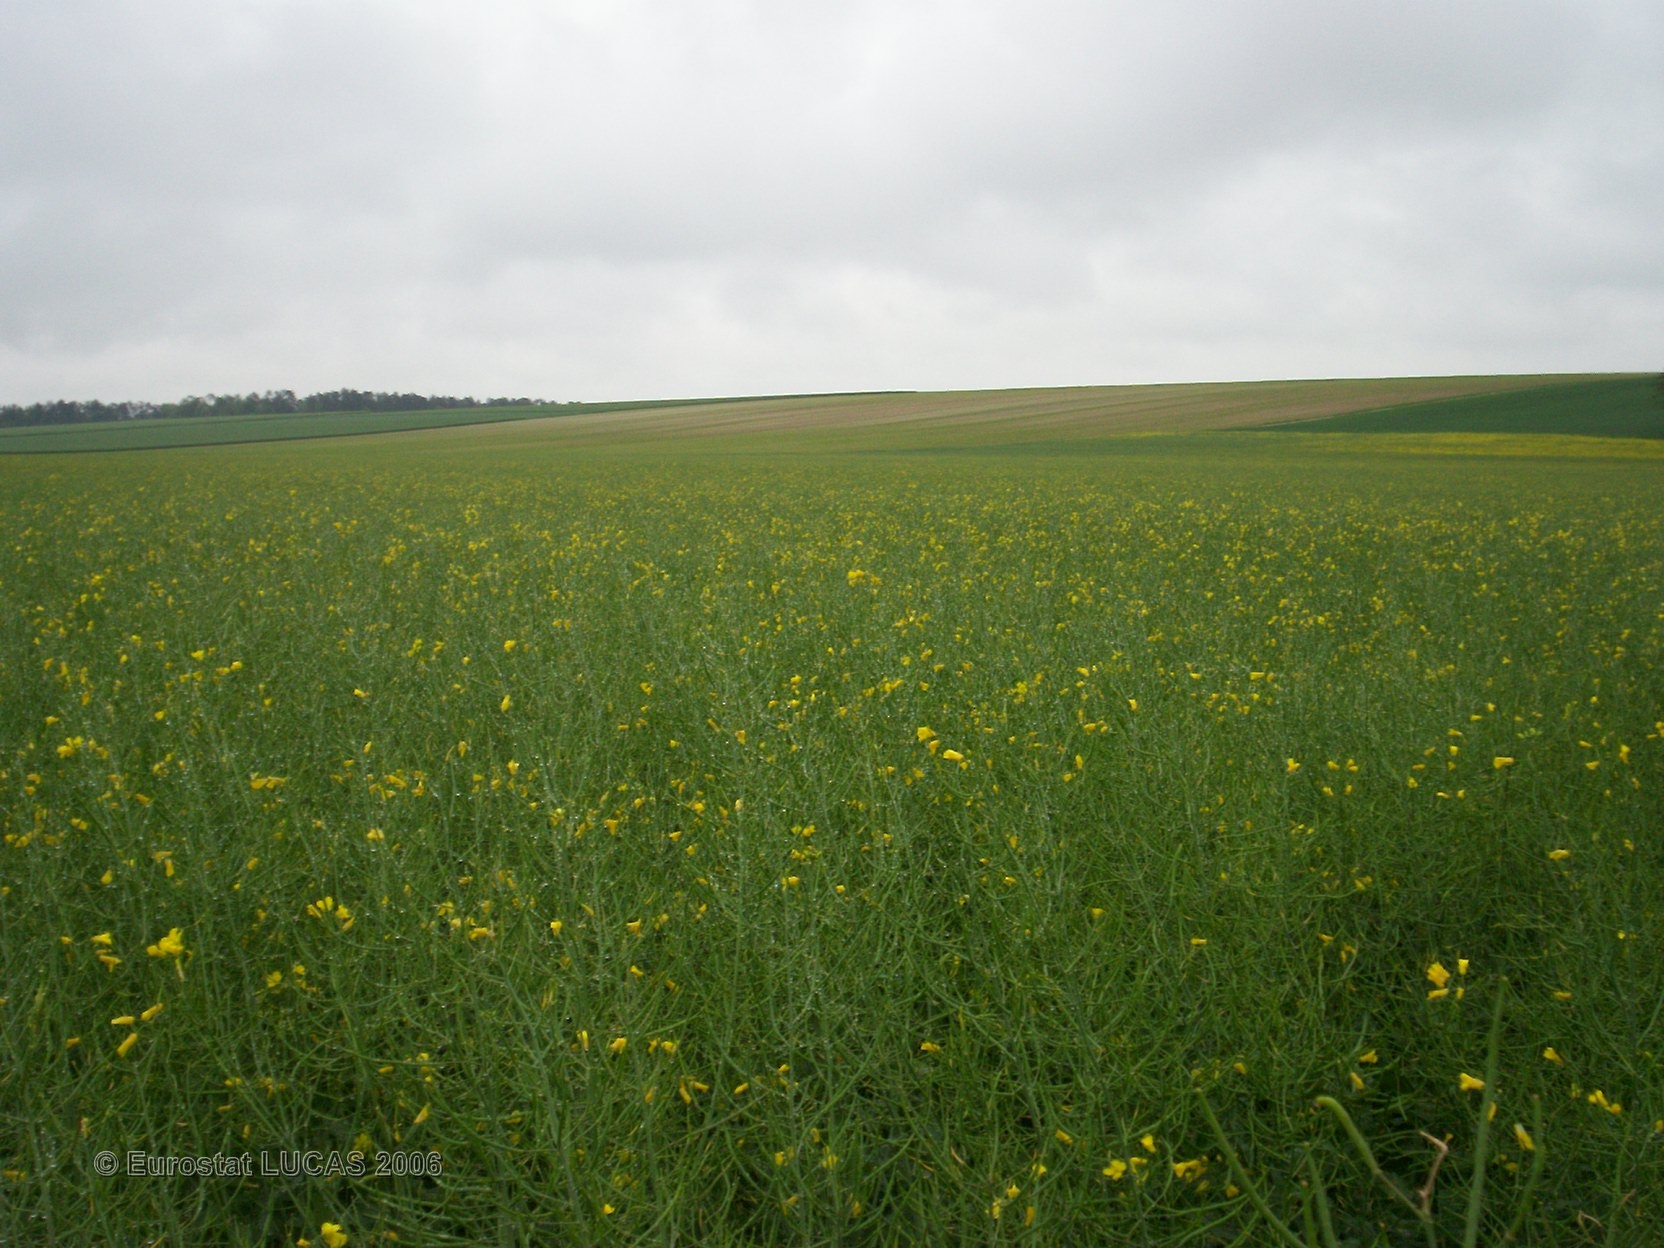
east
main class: Cropland
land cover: Rape and turnip rape
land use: Agriculture (excluding fallow land and kitchen gardens)
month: May
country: FR
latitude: 49.4177
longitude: 4.4409
